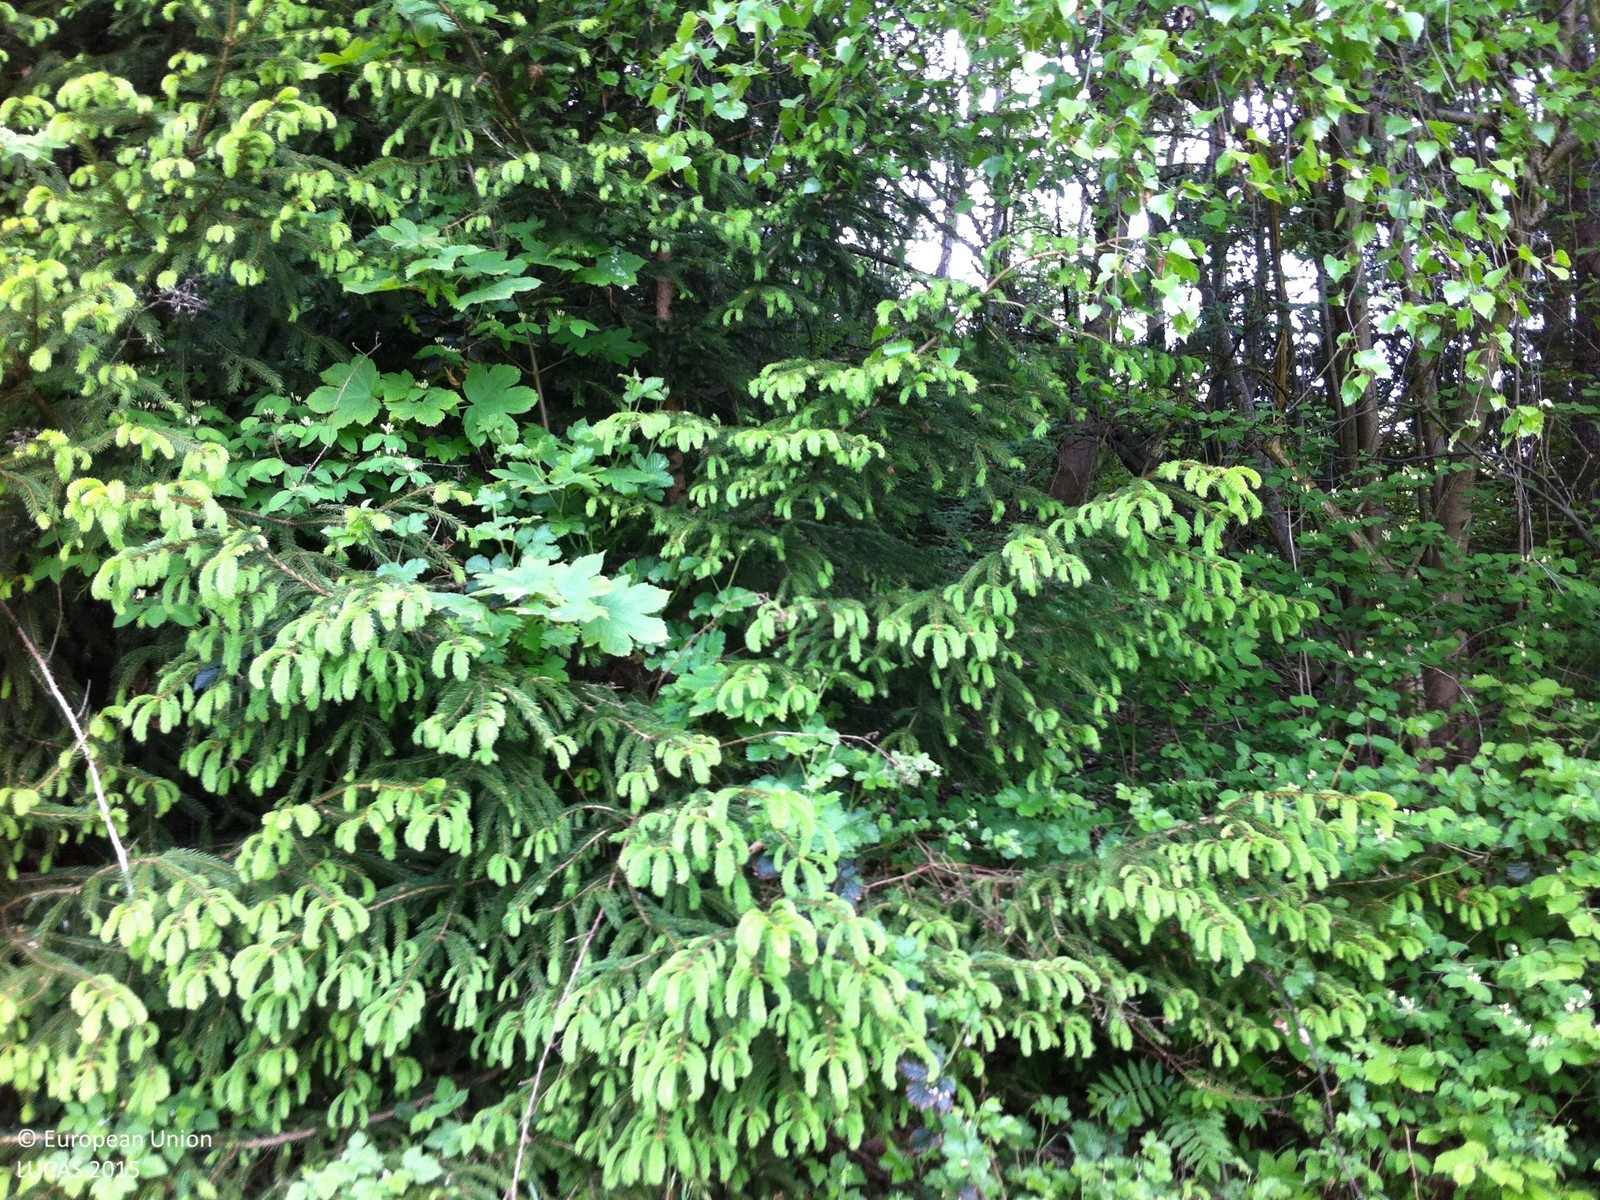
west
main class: Grassland
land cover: Grassland without tree/shrub cover
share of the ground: > 75 %
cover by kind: herbaceous plants 100 %
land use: Agriculture (excluding fallow land and kitchen gardens)
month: May
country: AT
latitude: 47.2427
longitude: 11.3859
